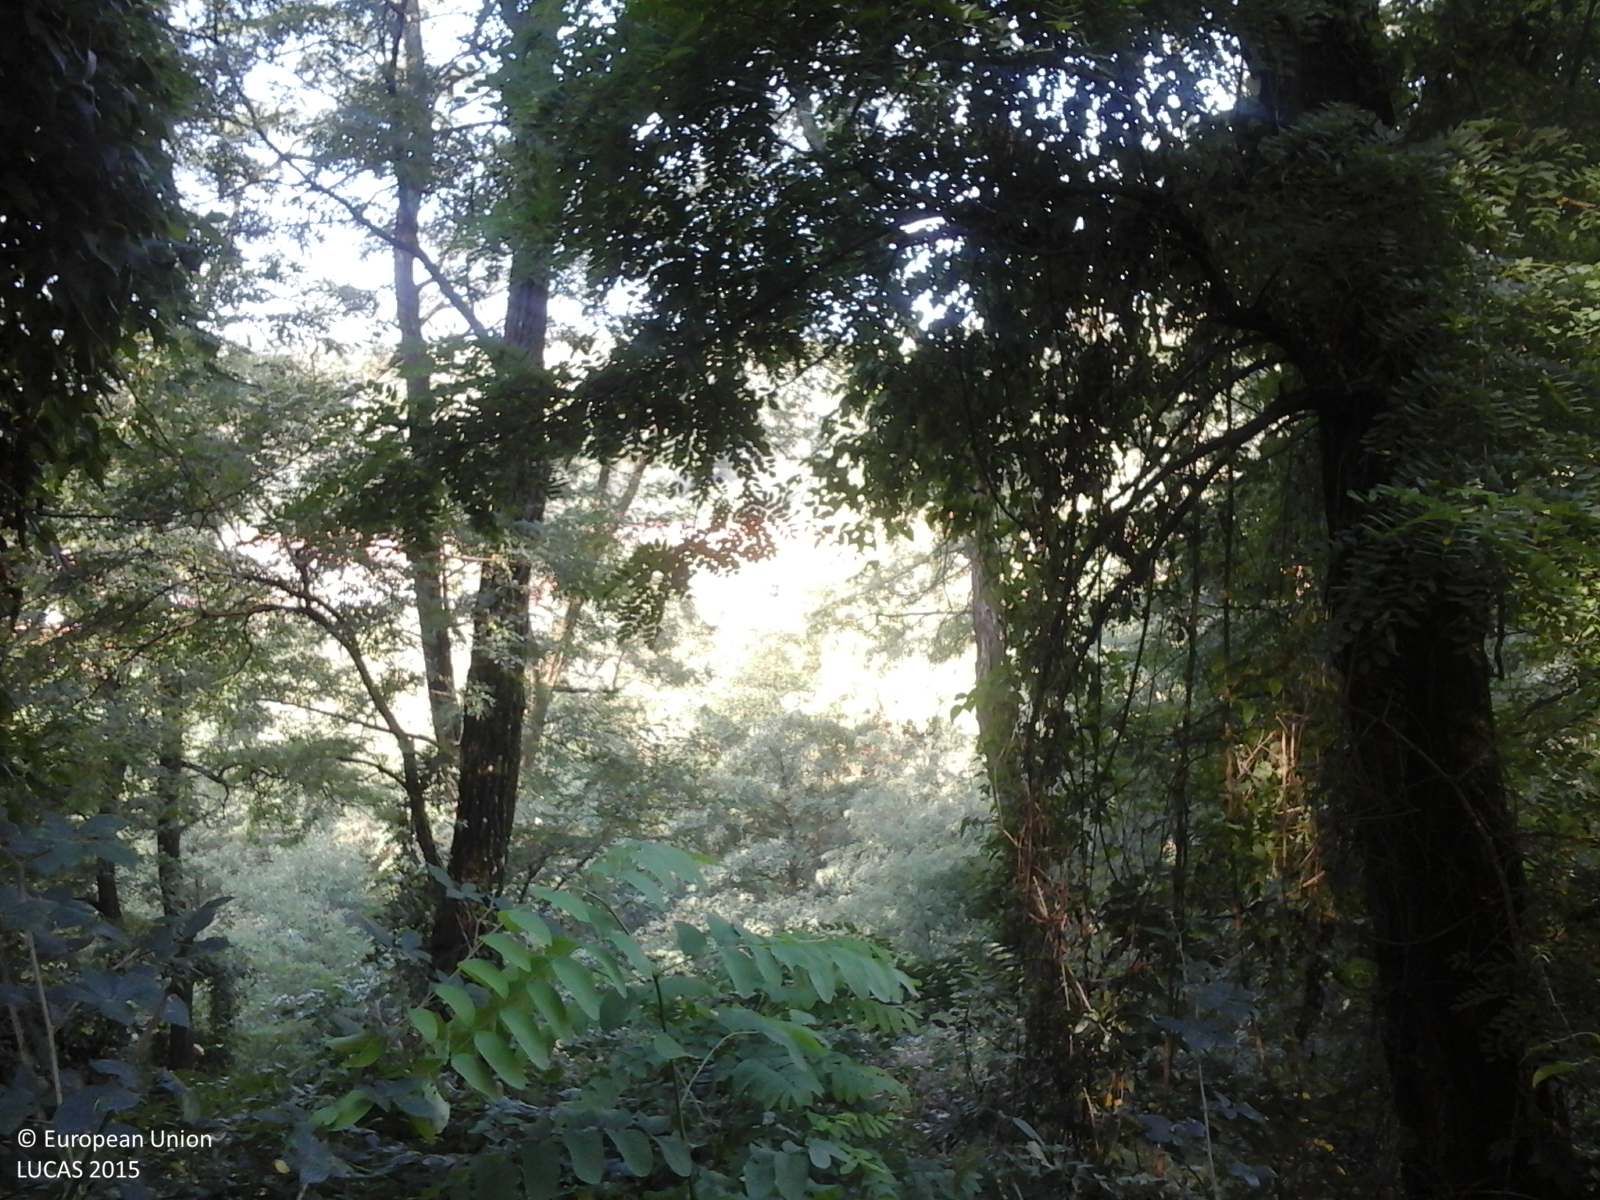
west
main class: Woodland
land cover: Broadleaved woodland
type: exotic forest
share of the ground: > 75 %
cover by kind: broadleaved forest trees 100 %
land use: Forestry
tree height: > 5 m
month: September
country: RO
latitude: 45.0887
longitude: 22.3264
